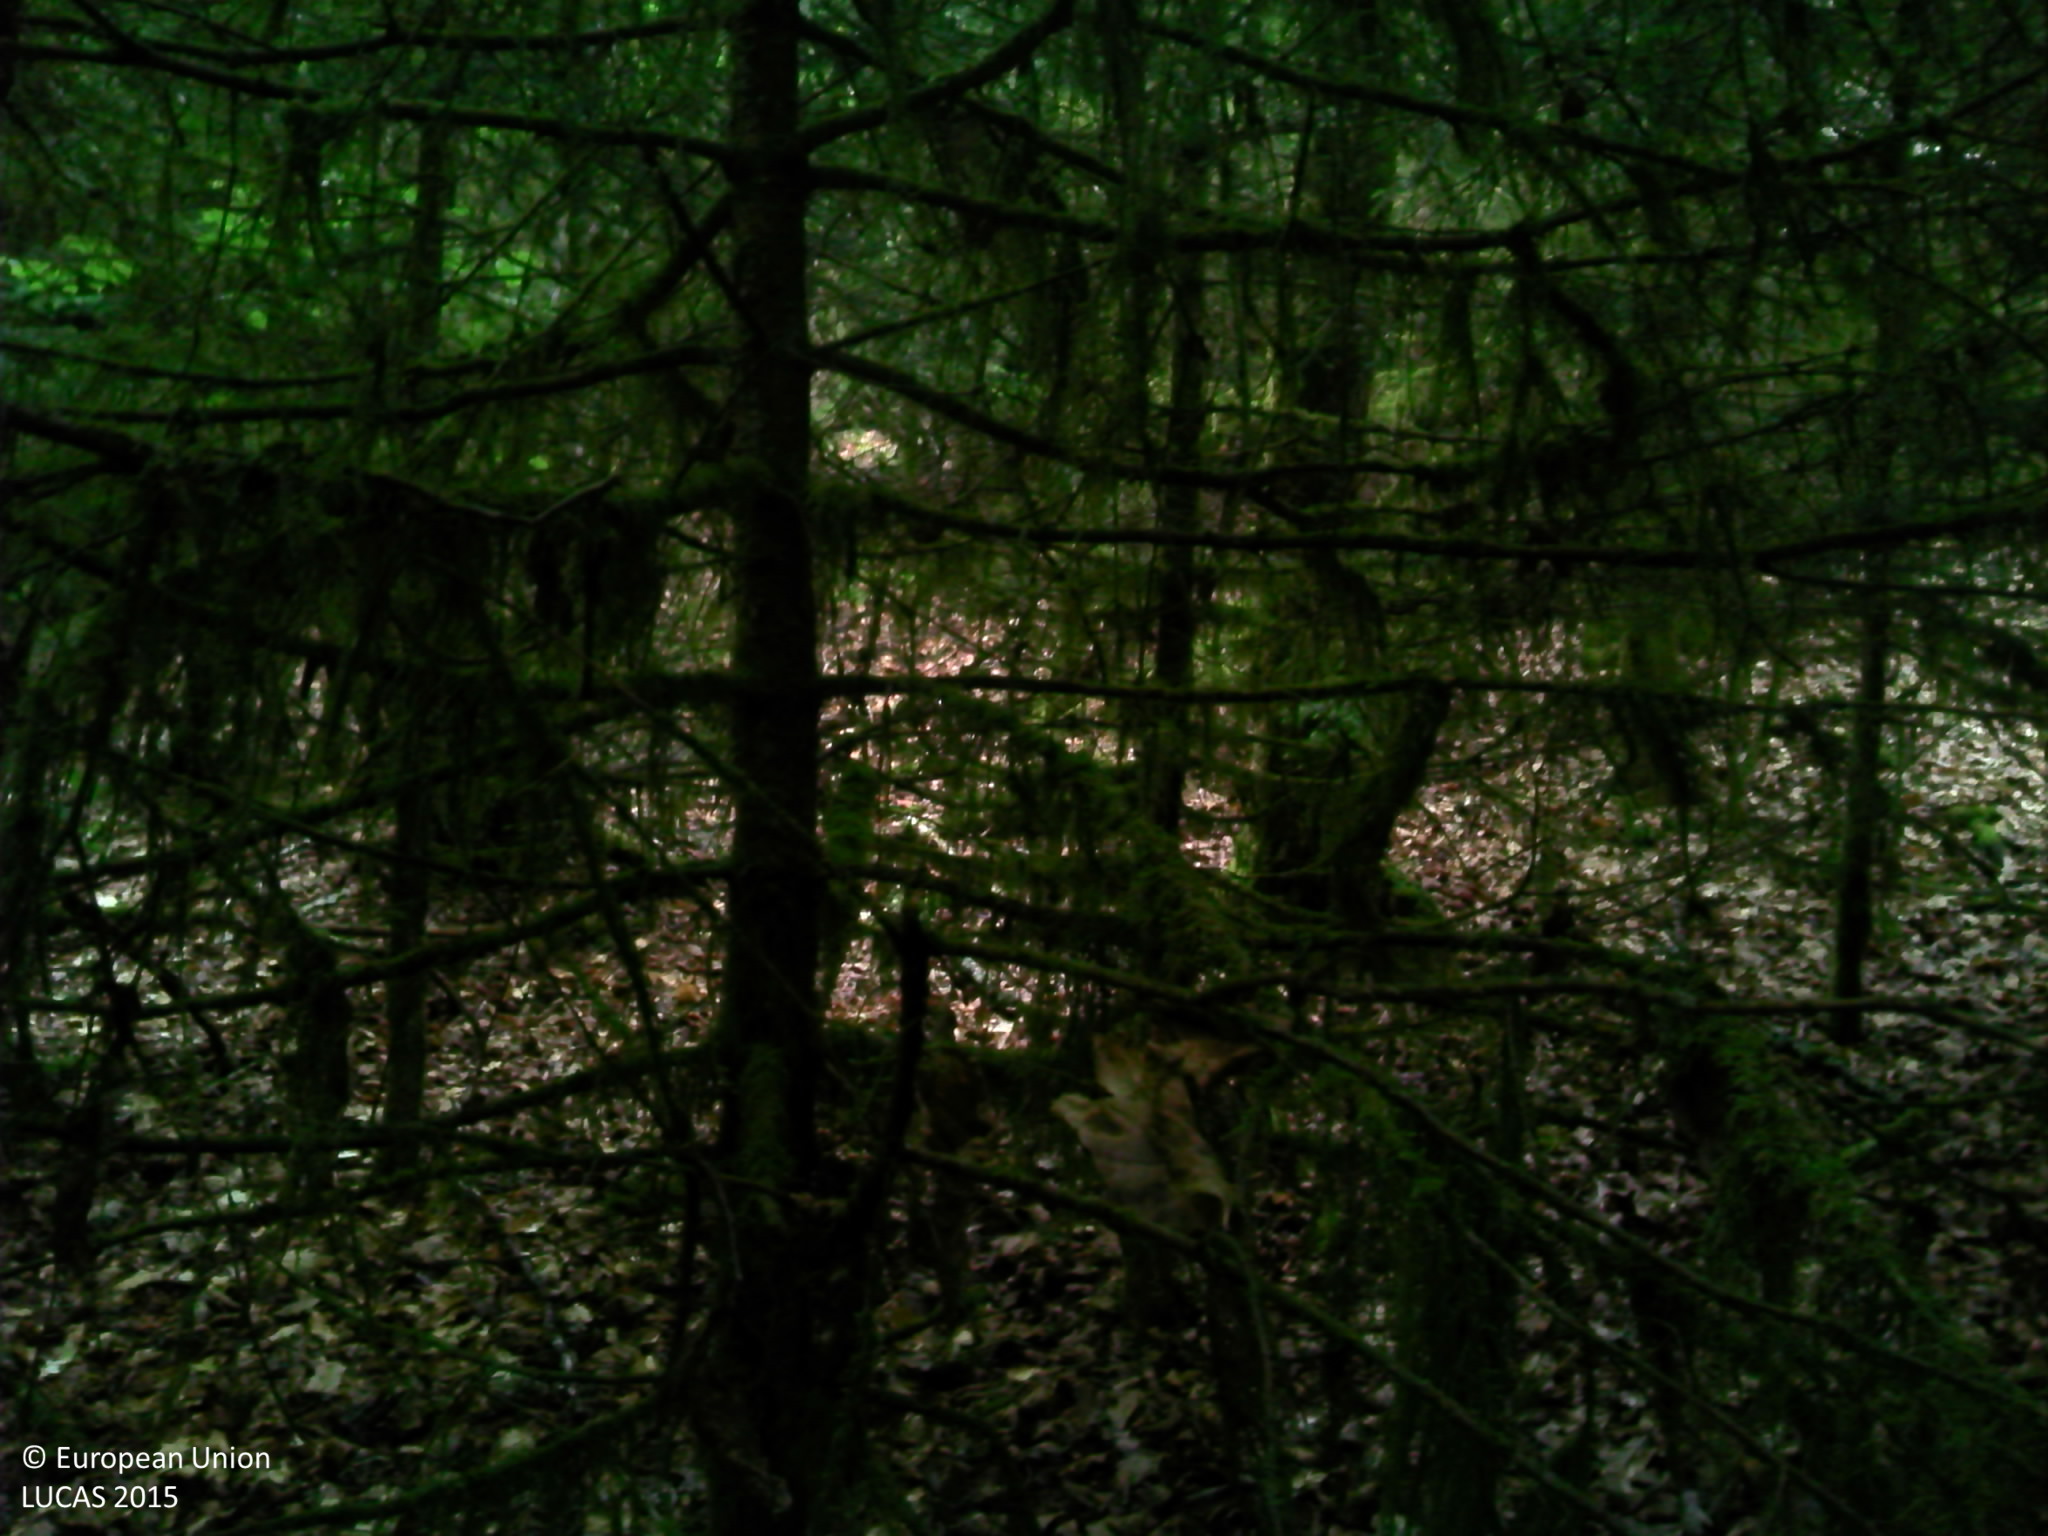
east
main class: Woodland
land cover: Spruce dominated coniferous woodland
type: beech forest
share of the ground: > 75 %
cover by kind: coniferous forest trees 80 %, broadleaved forest trees 20 %
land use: Forestry
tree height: > 5 m
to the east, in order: Spruce dominated coniferous woodland; Spruce dominated mixed woodland; Spruce dominated coniferous woodland; Grass margins; Tracks; Grass margins; Spruce dominated coniferous woodland
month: June
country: FR
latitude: 47.8467
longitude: 6.5936
